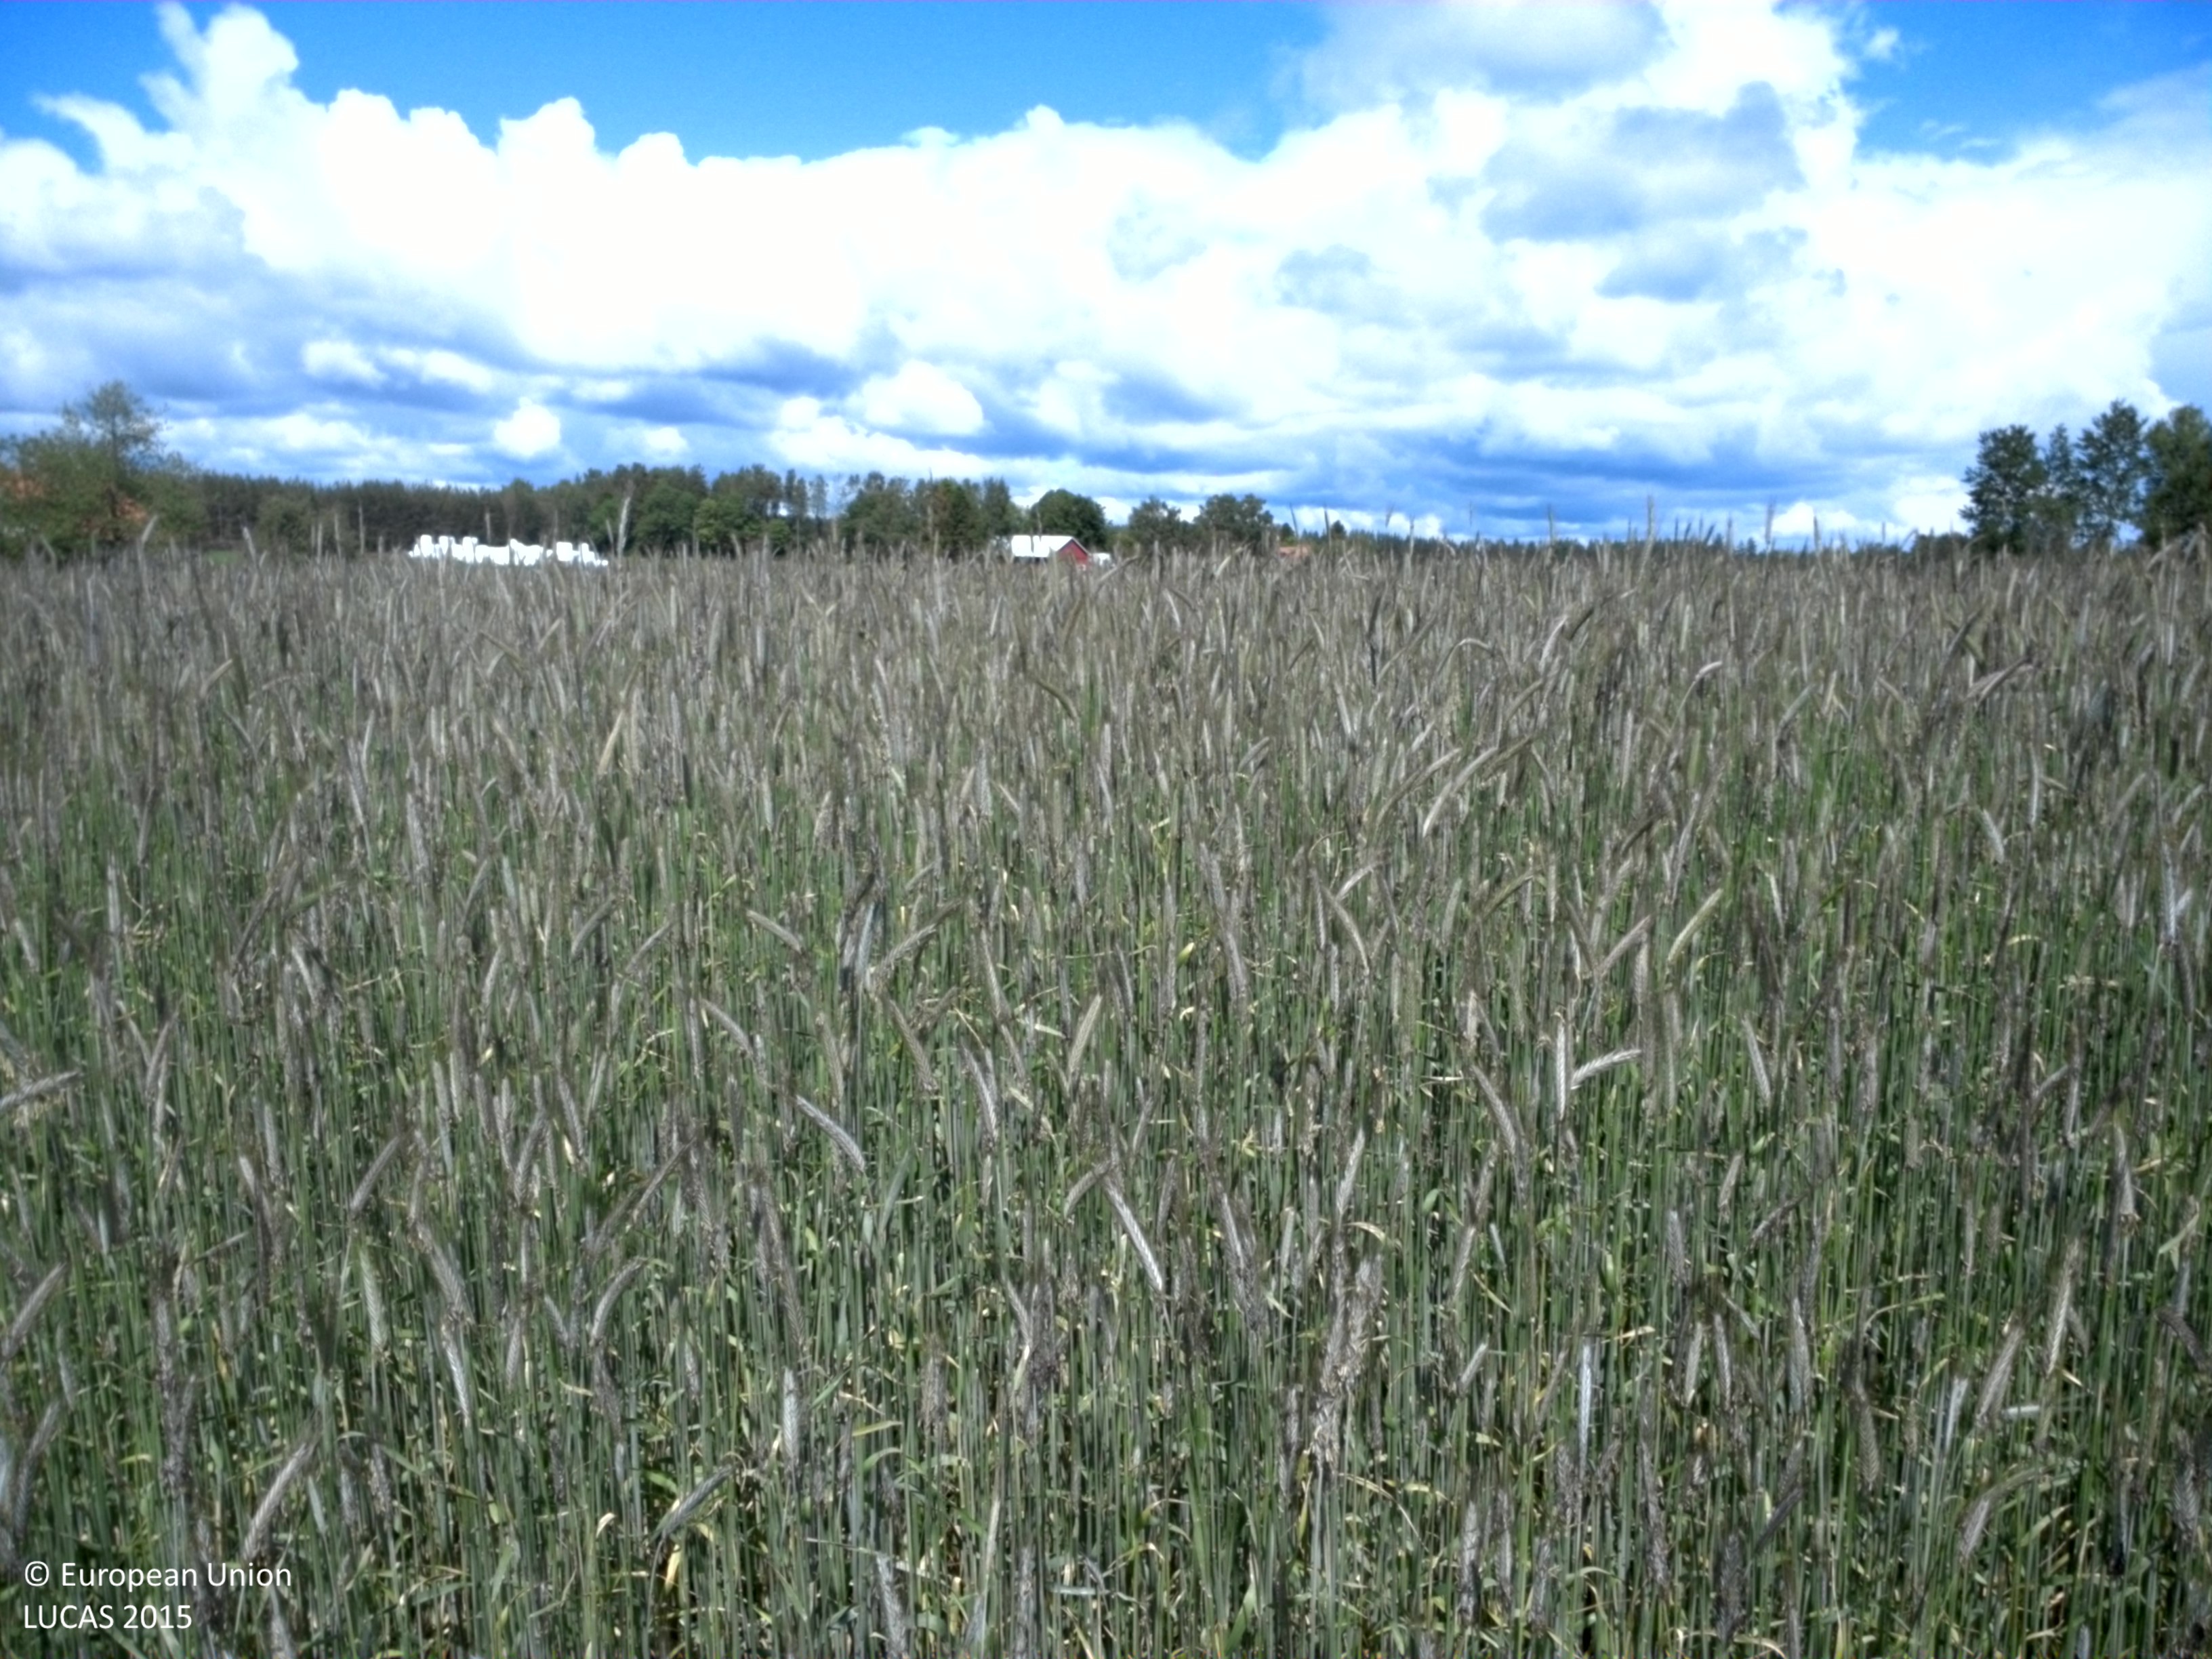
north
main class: Cropland
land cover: Rye
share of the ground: > 75 %
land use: Agriculture (excluding fallow land and kitchen gardens)
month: June
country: SE
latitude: 58.4539
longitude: 14.3977
